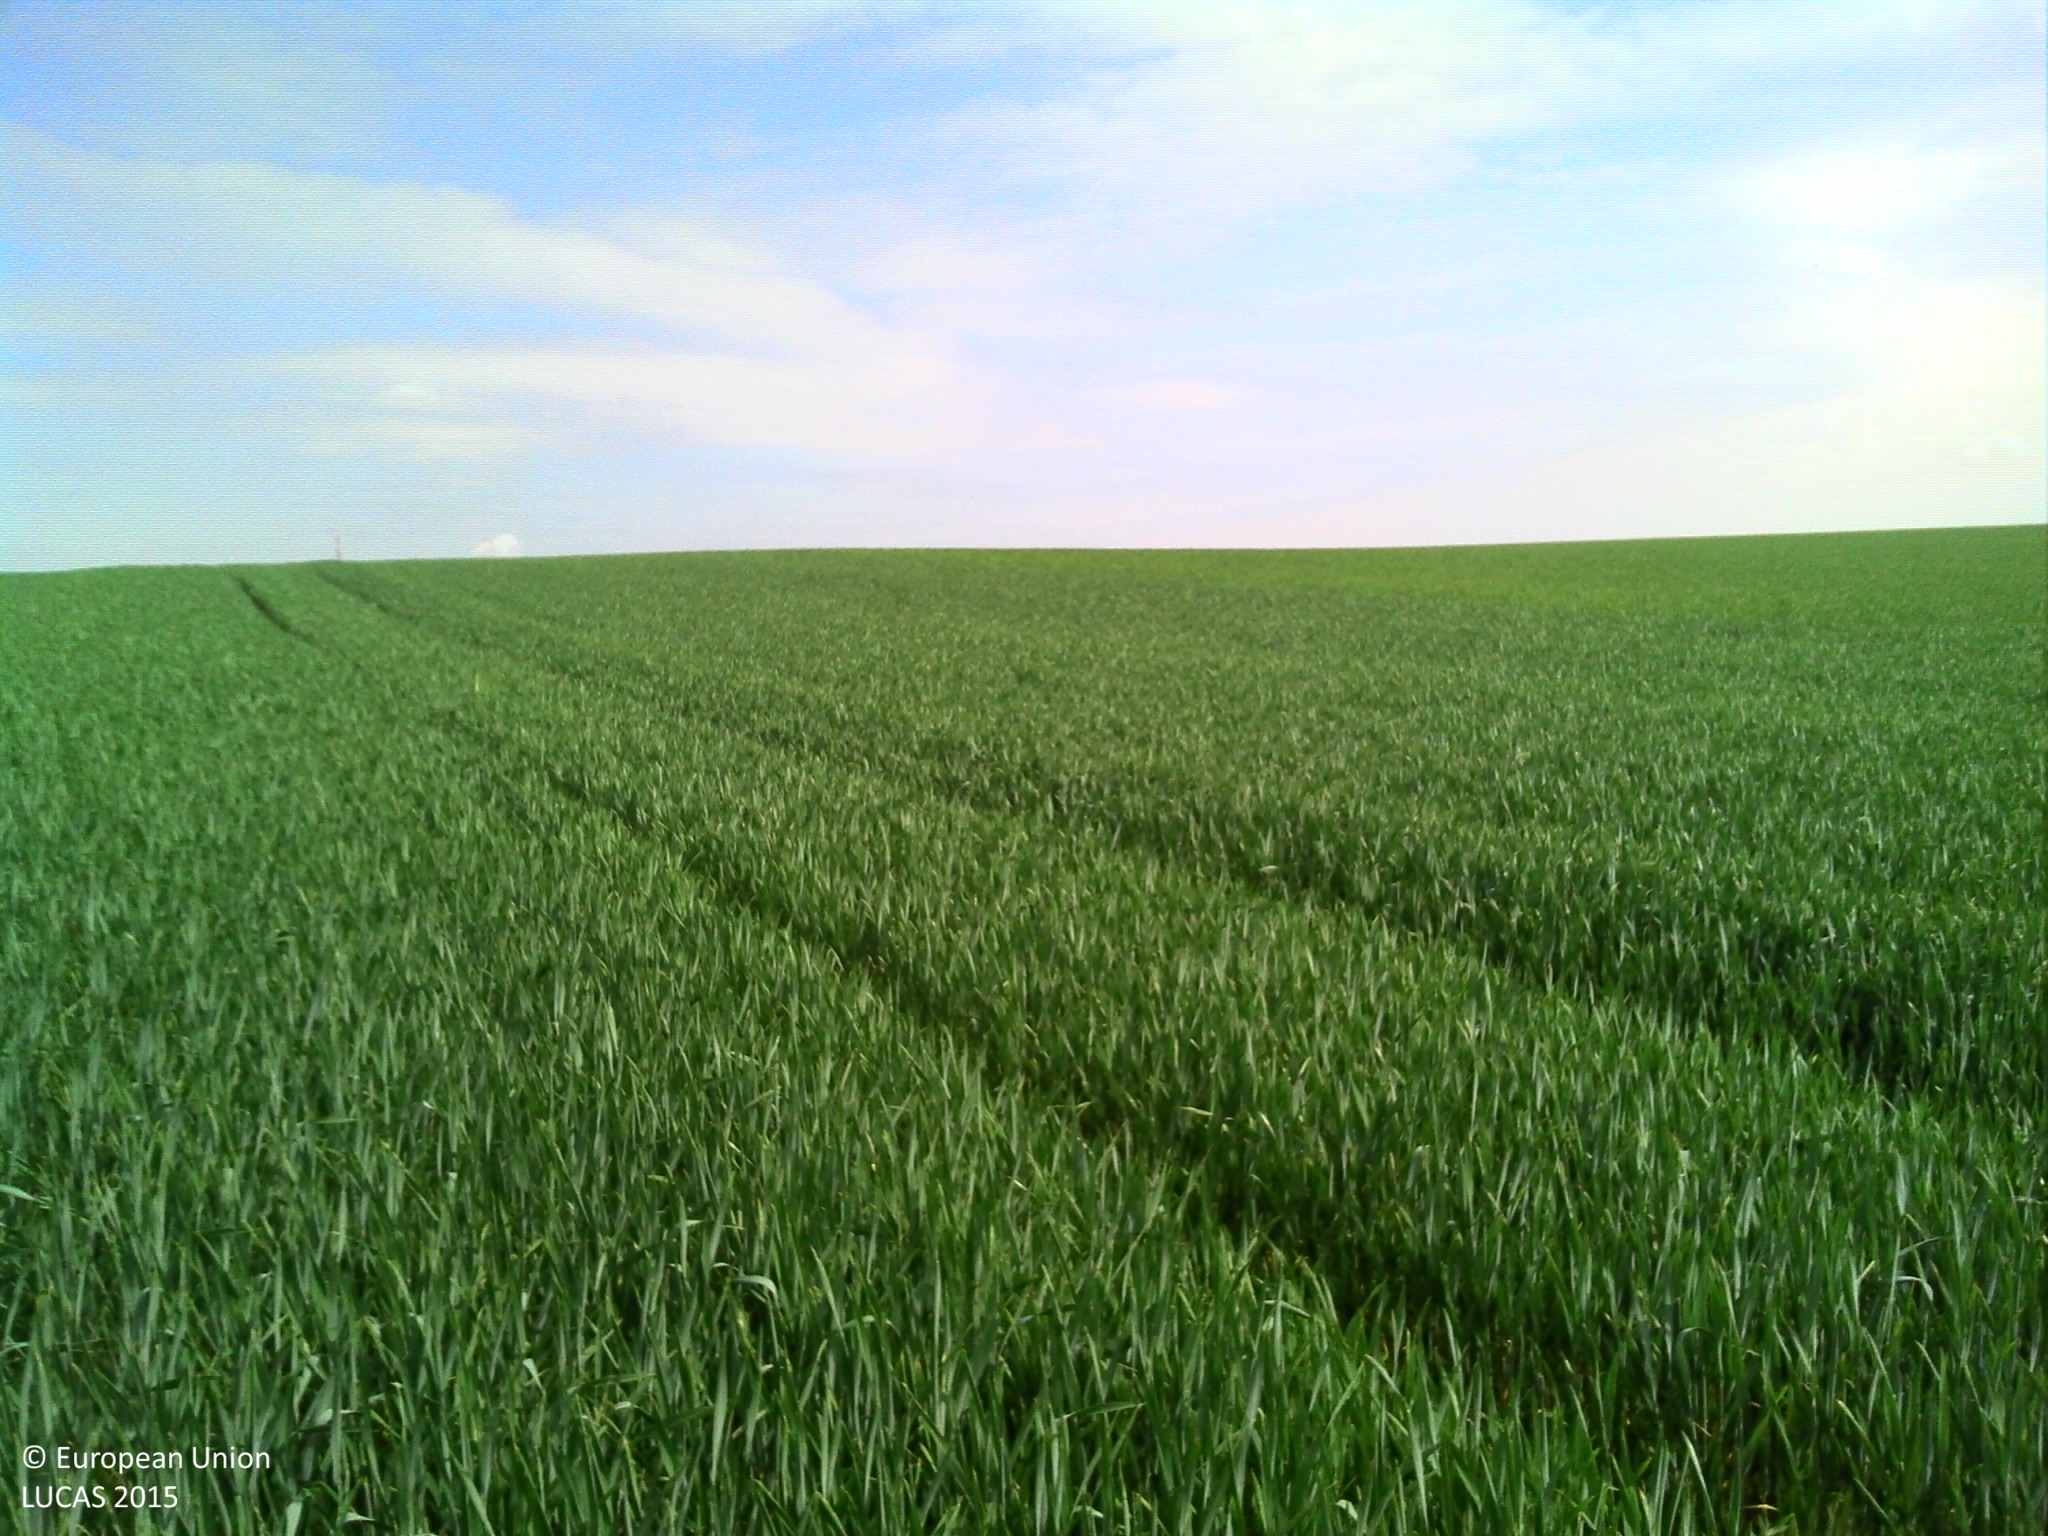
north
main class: Cropland
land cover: Common wheat
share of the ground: > 75 %
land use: Agriculture (excluding fallow land and kitchen gardens)
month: May
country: BE
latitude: 50.5784
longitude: 4.5874
